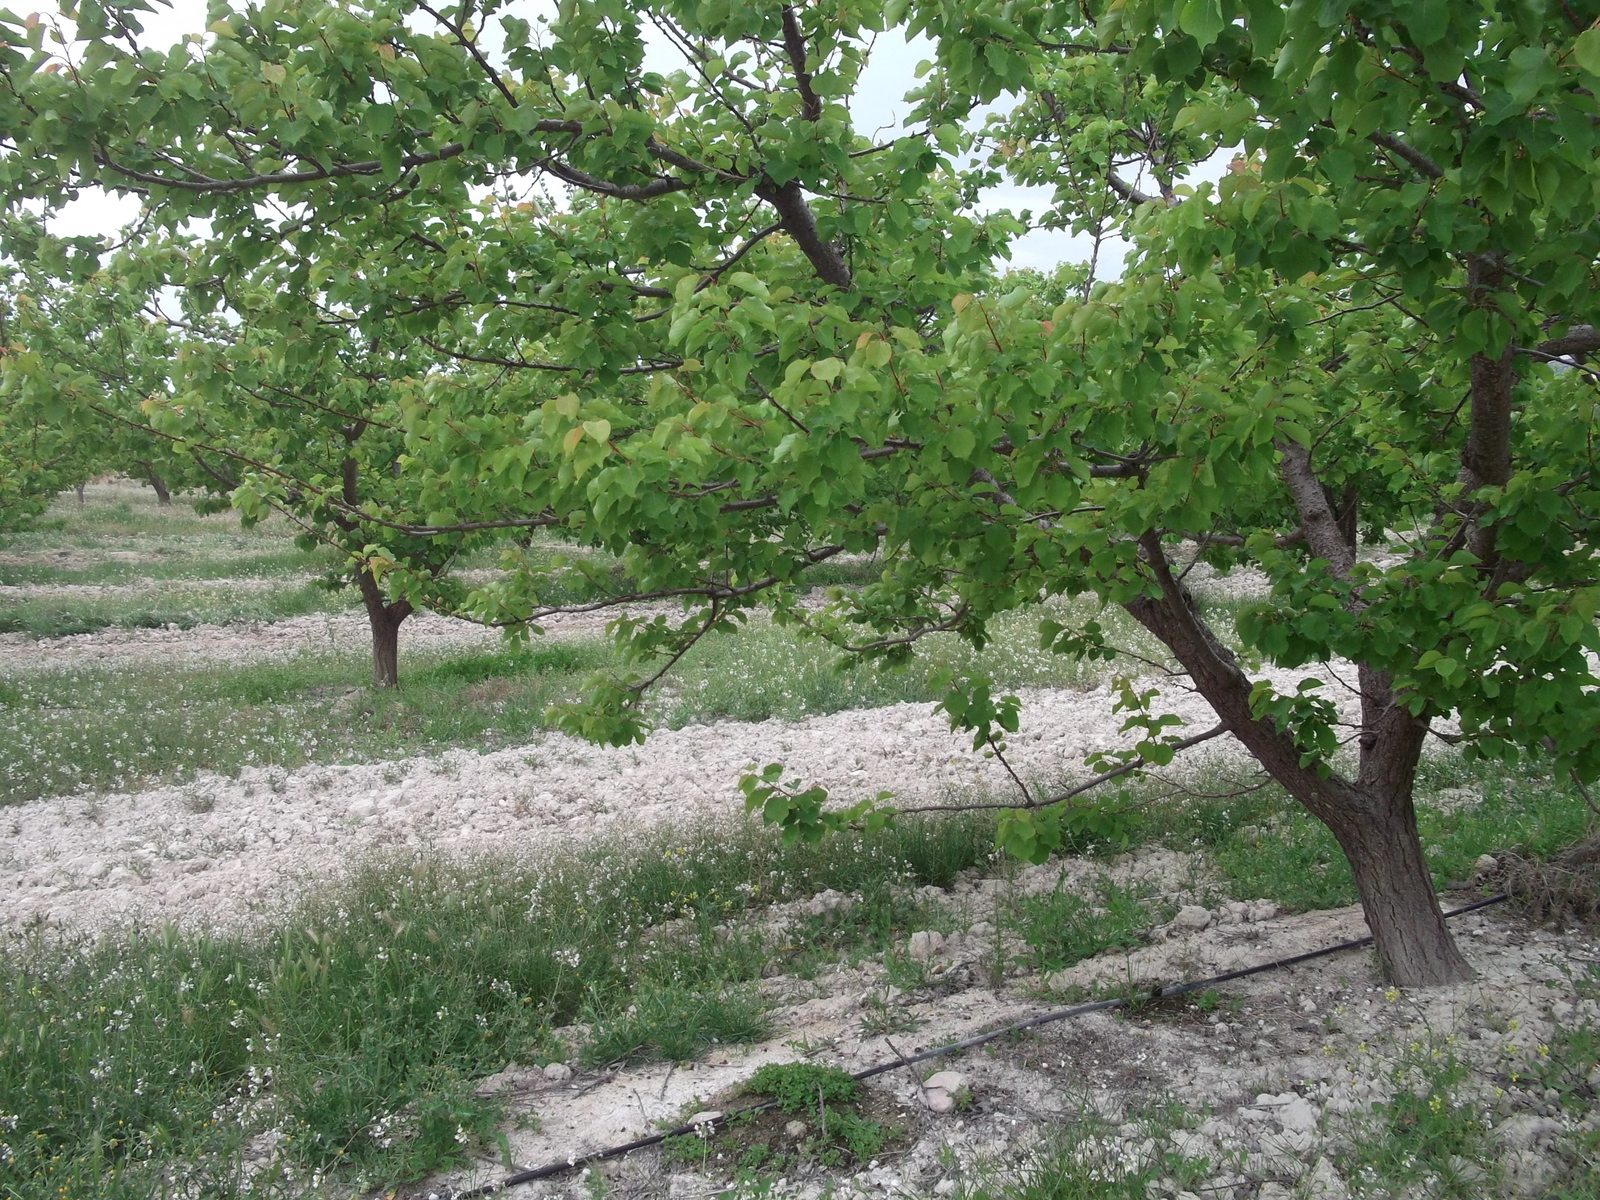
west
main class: Cropland
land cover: Other fruit trees and berries
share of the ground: 10 - 25 %
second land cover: Spontaneously vegetated surfaces
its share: > 75 %
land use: Agriculture (excluding fallow land and kitchen gardens)
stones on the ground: < 10 %
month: April
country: ES
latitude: 38.0609
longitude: -1.4407
